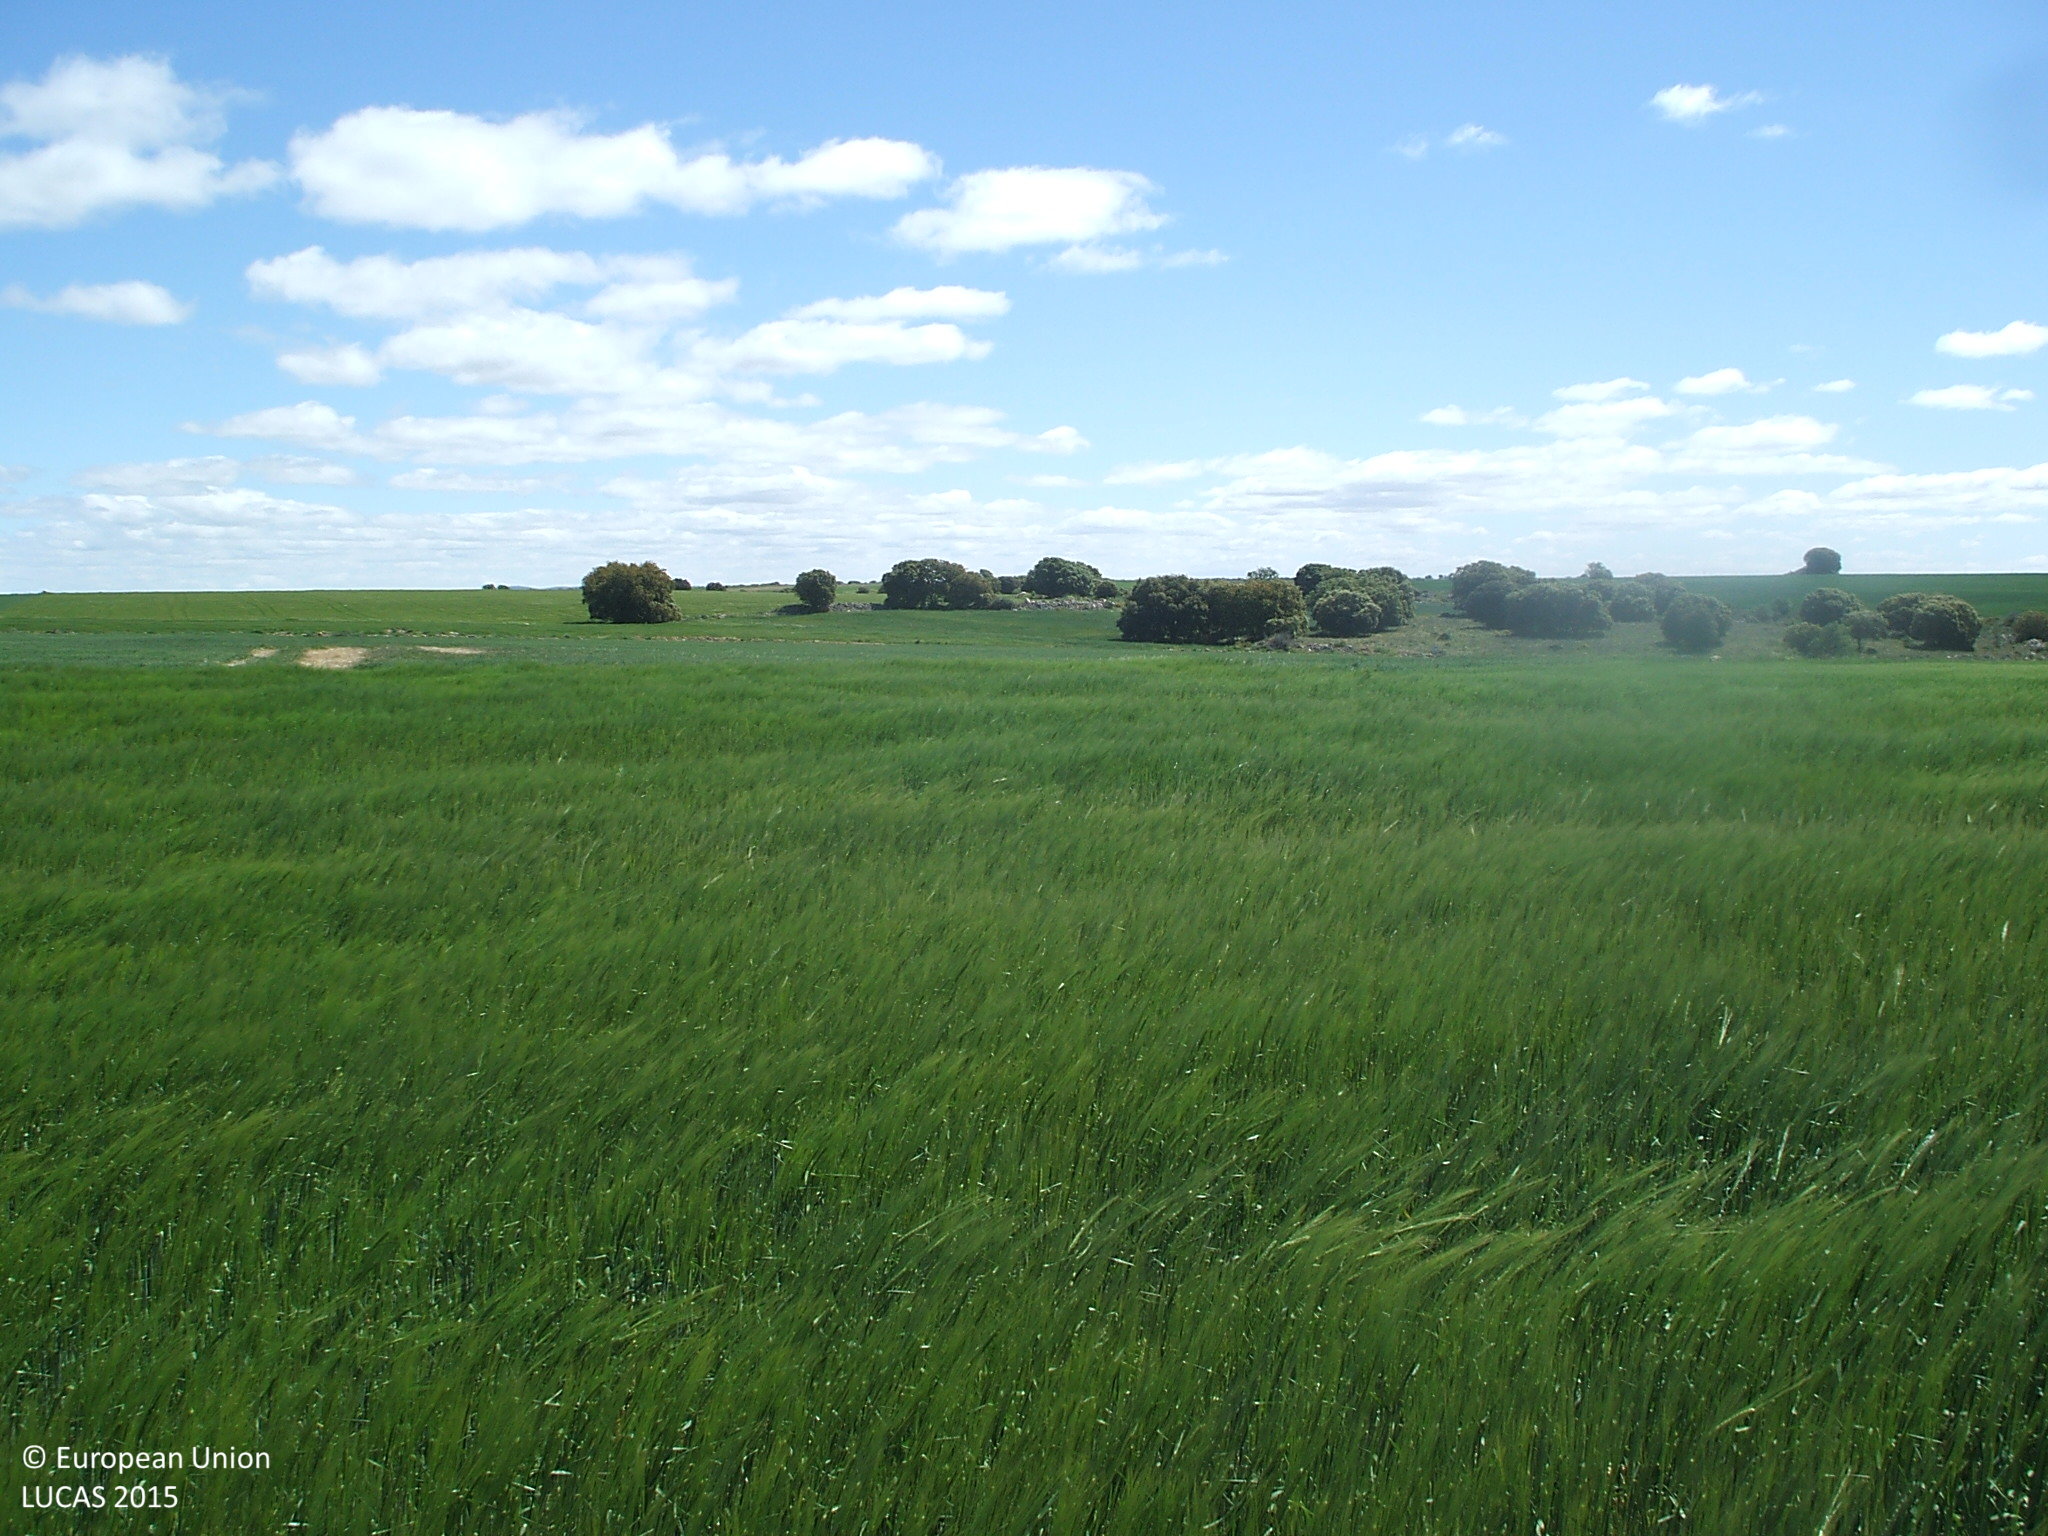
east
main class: Cropland
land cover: Barley
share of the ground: > 75 %
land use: Agriculture (excluding fallow land and kitchen gardens)
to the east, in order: Barley; Tracks; Grassland with sparse tree/shrub cover
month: May
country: ES
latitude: 40.8980
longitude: -2.8647
